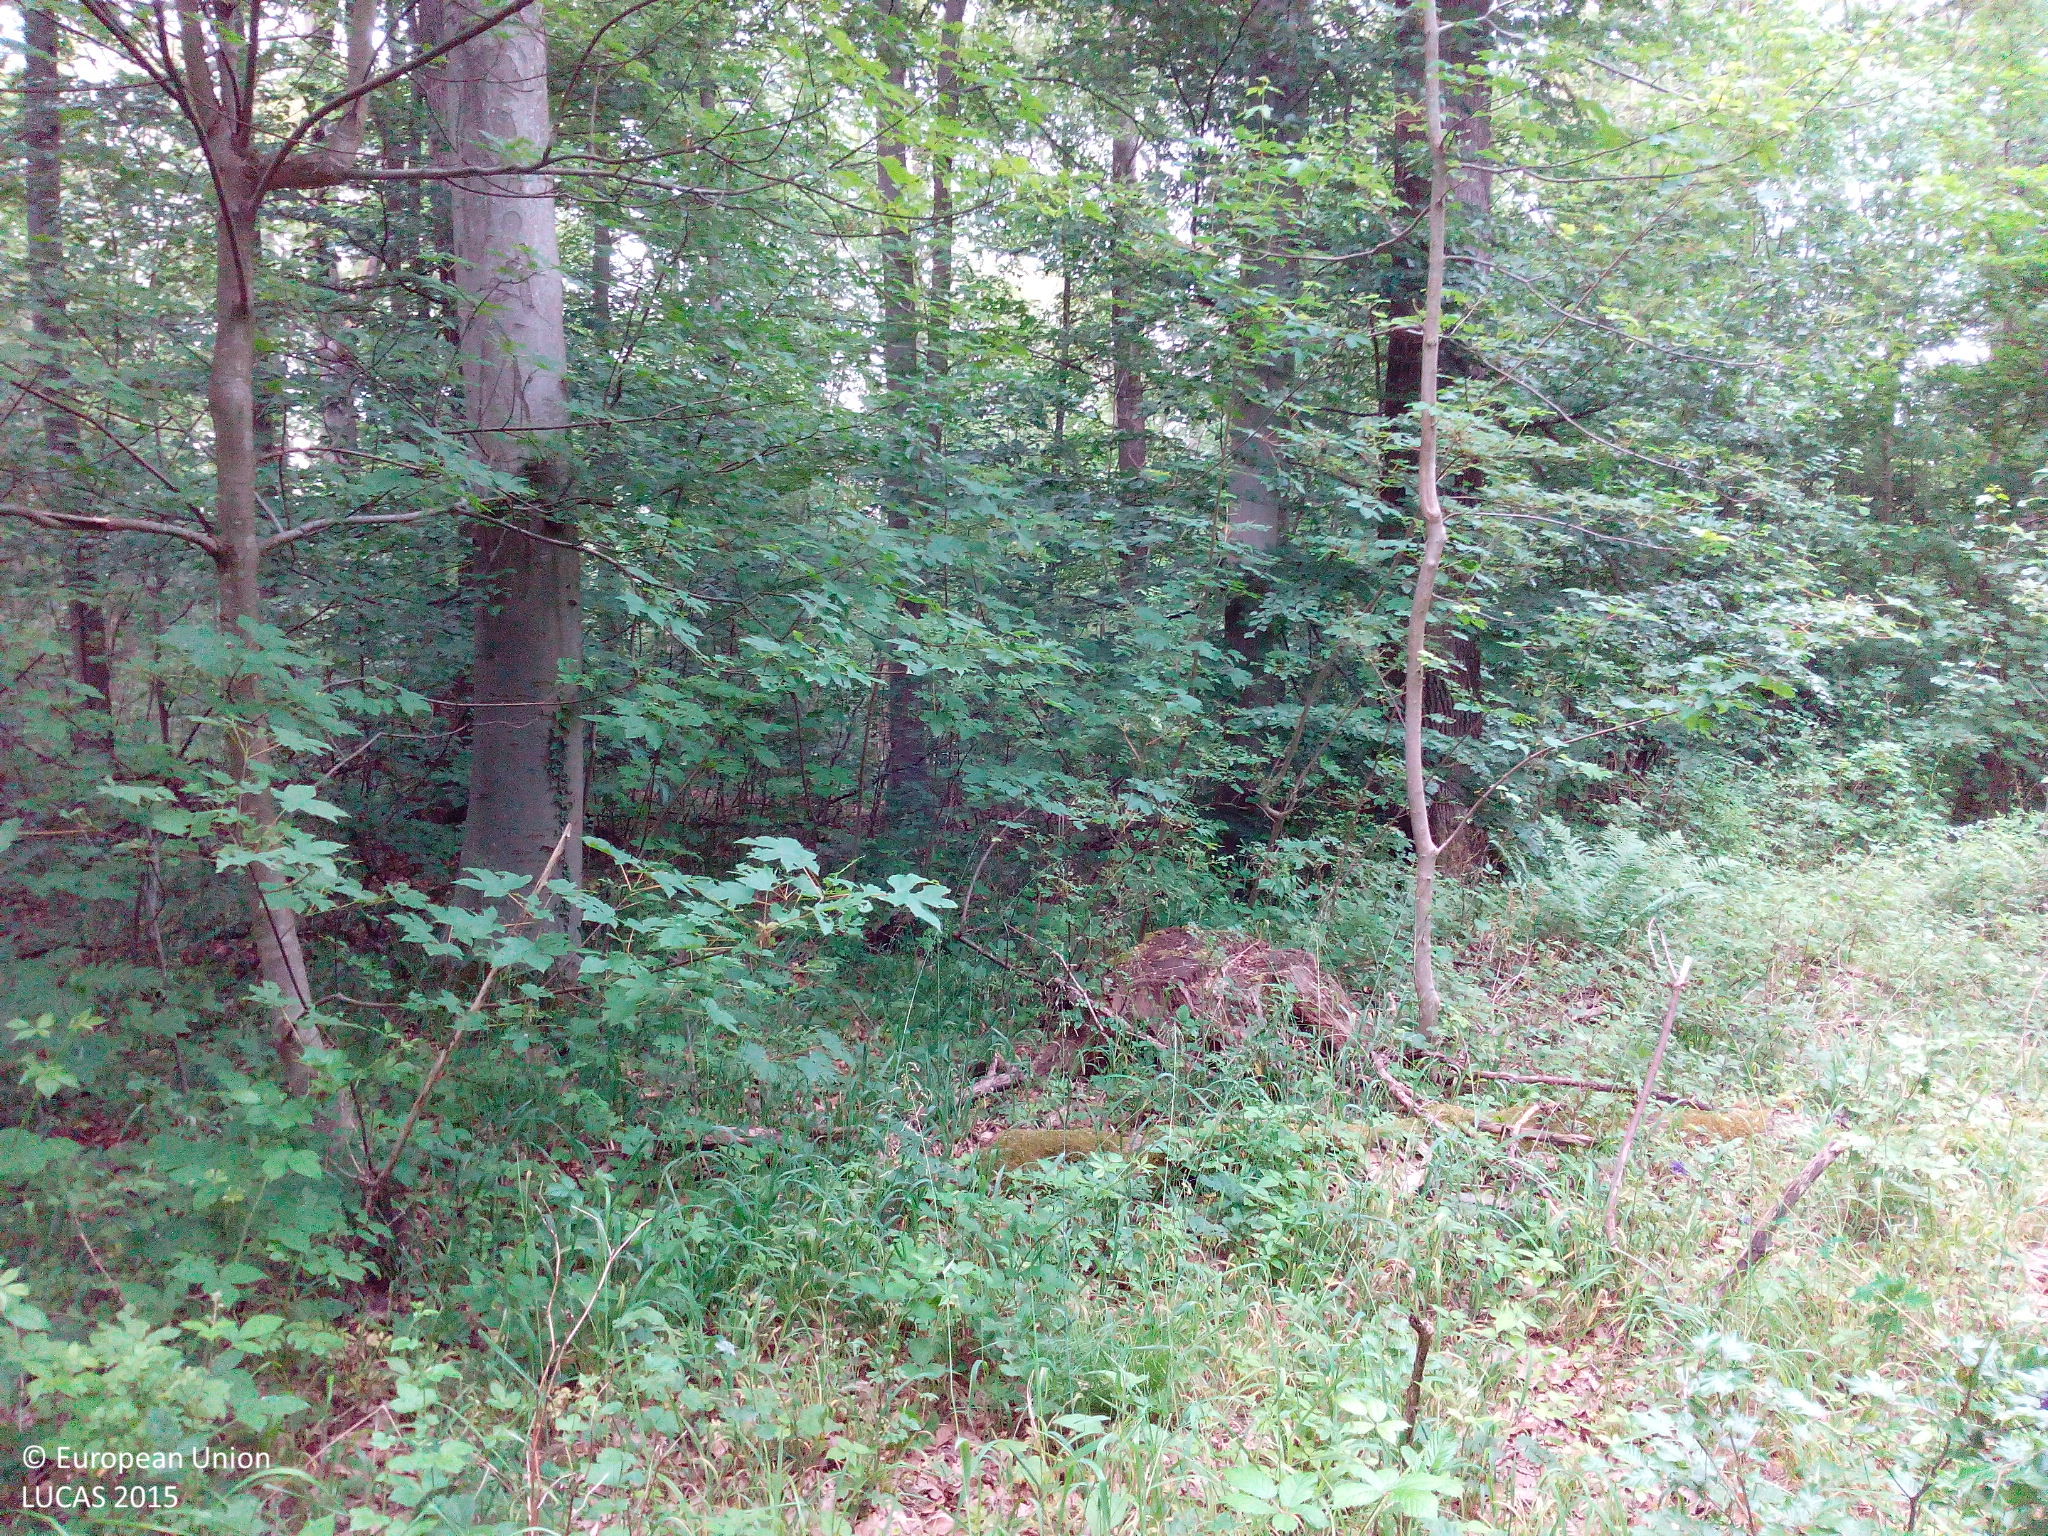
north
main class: Woodland
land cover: Broadleaved woodland
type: mesophytic deciduous forest
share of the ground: > 75 %
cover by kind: broadleaved forest trees 90 %, shrubs 5 %, herbaceous plants 5 %
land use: Forestry
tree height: > 5 m
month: June
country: DE
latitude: 49.1388
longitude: 9.2738
